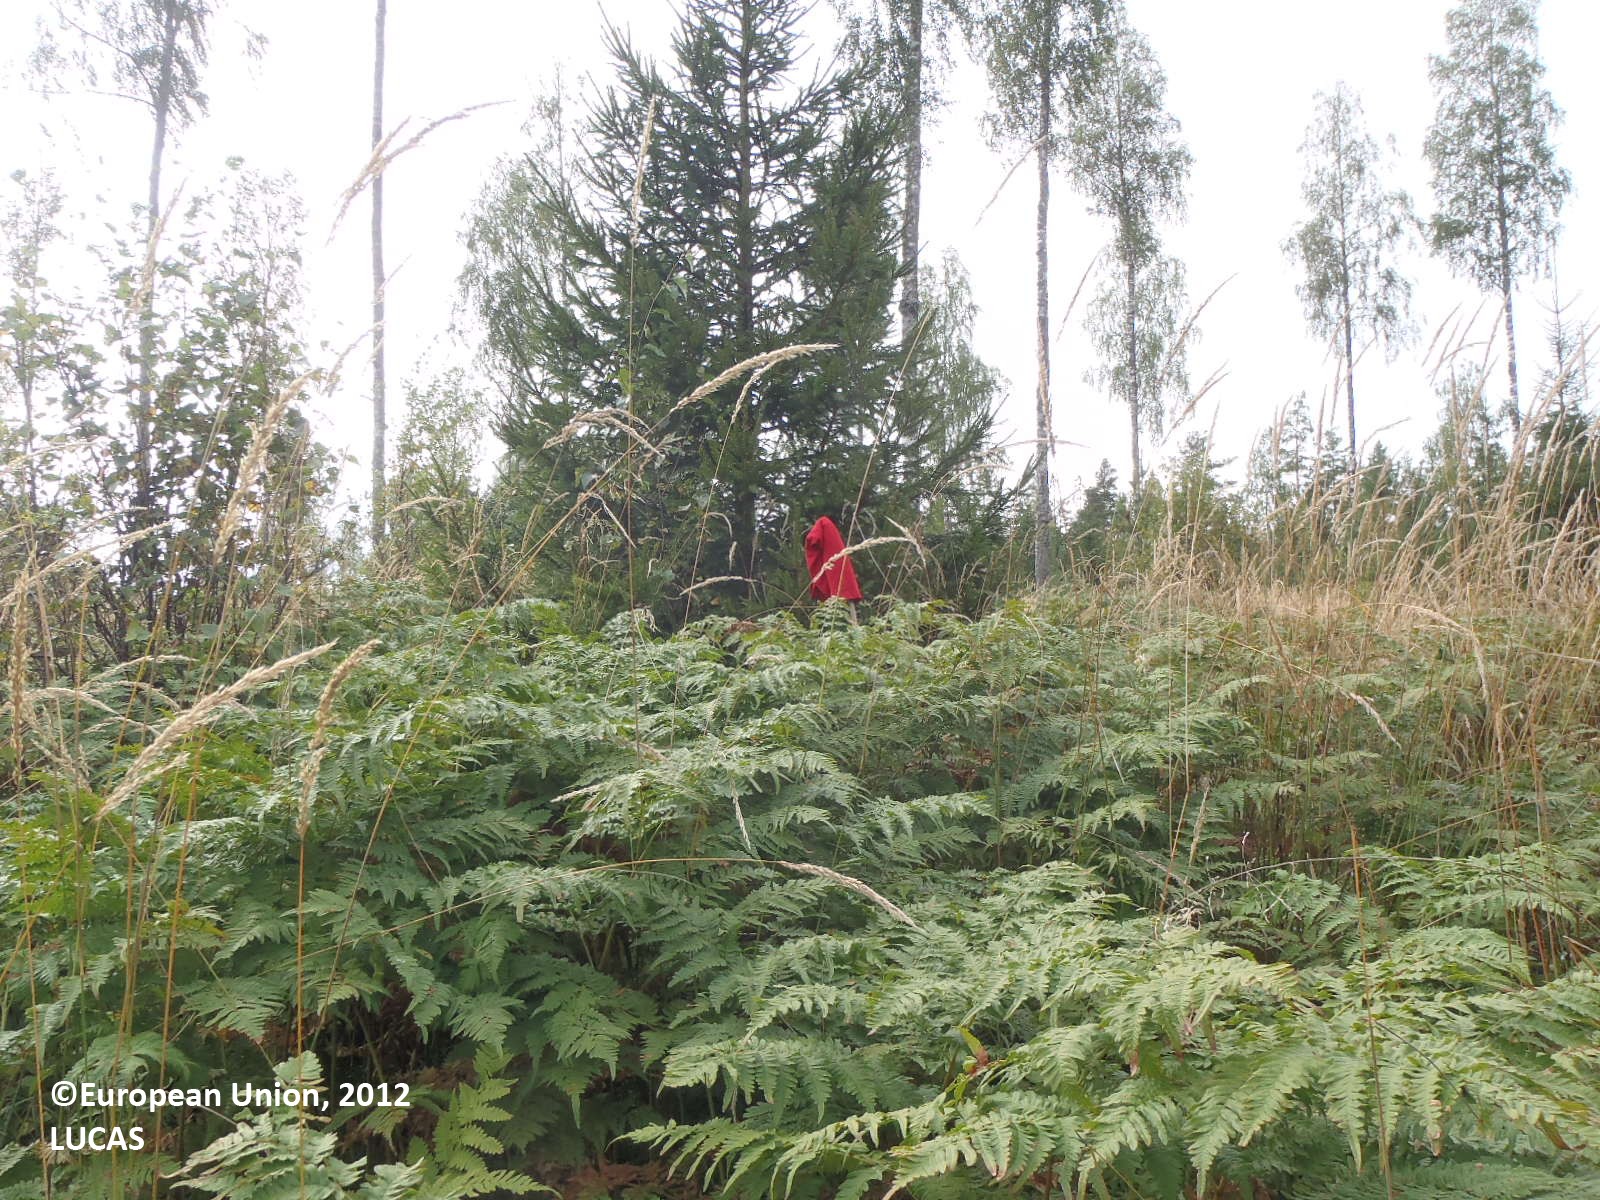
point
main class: Woodland
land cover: Other mixed woodland
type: boreal forest
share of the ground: 25 - 50 %
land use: Forestry
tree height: > 5 m
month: August
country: FI
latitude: 60.7728
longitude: 22.4981
